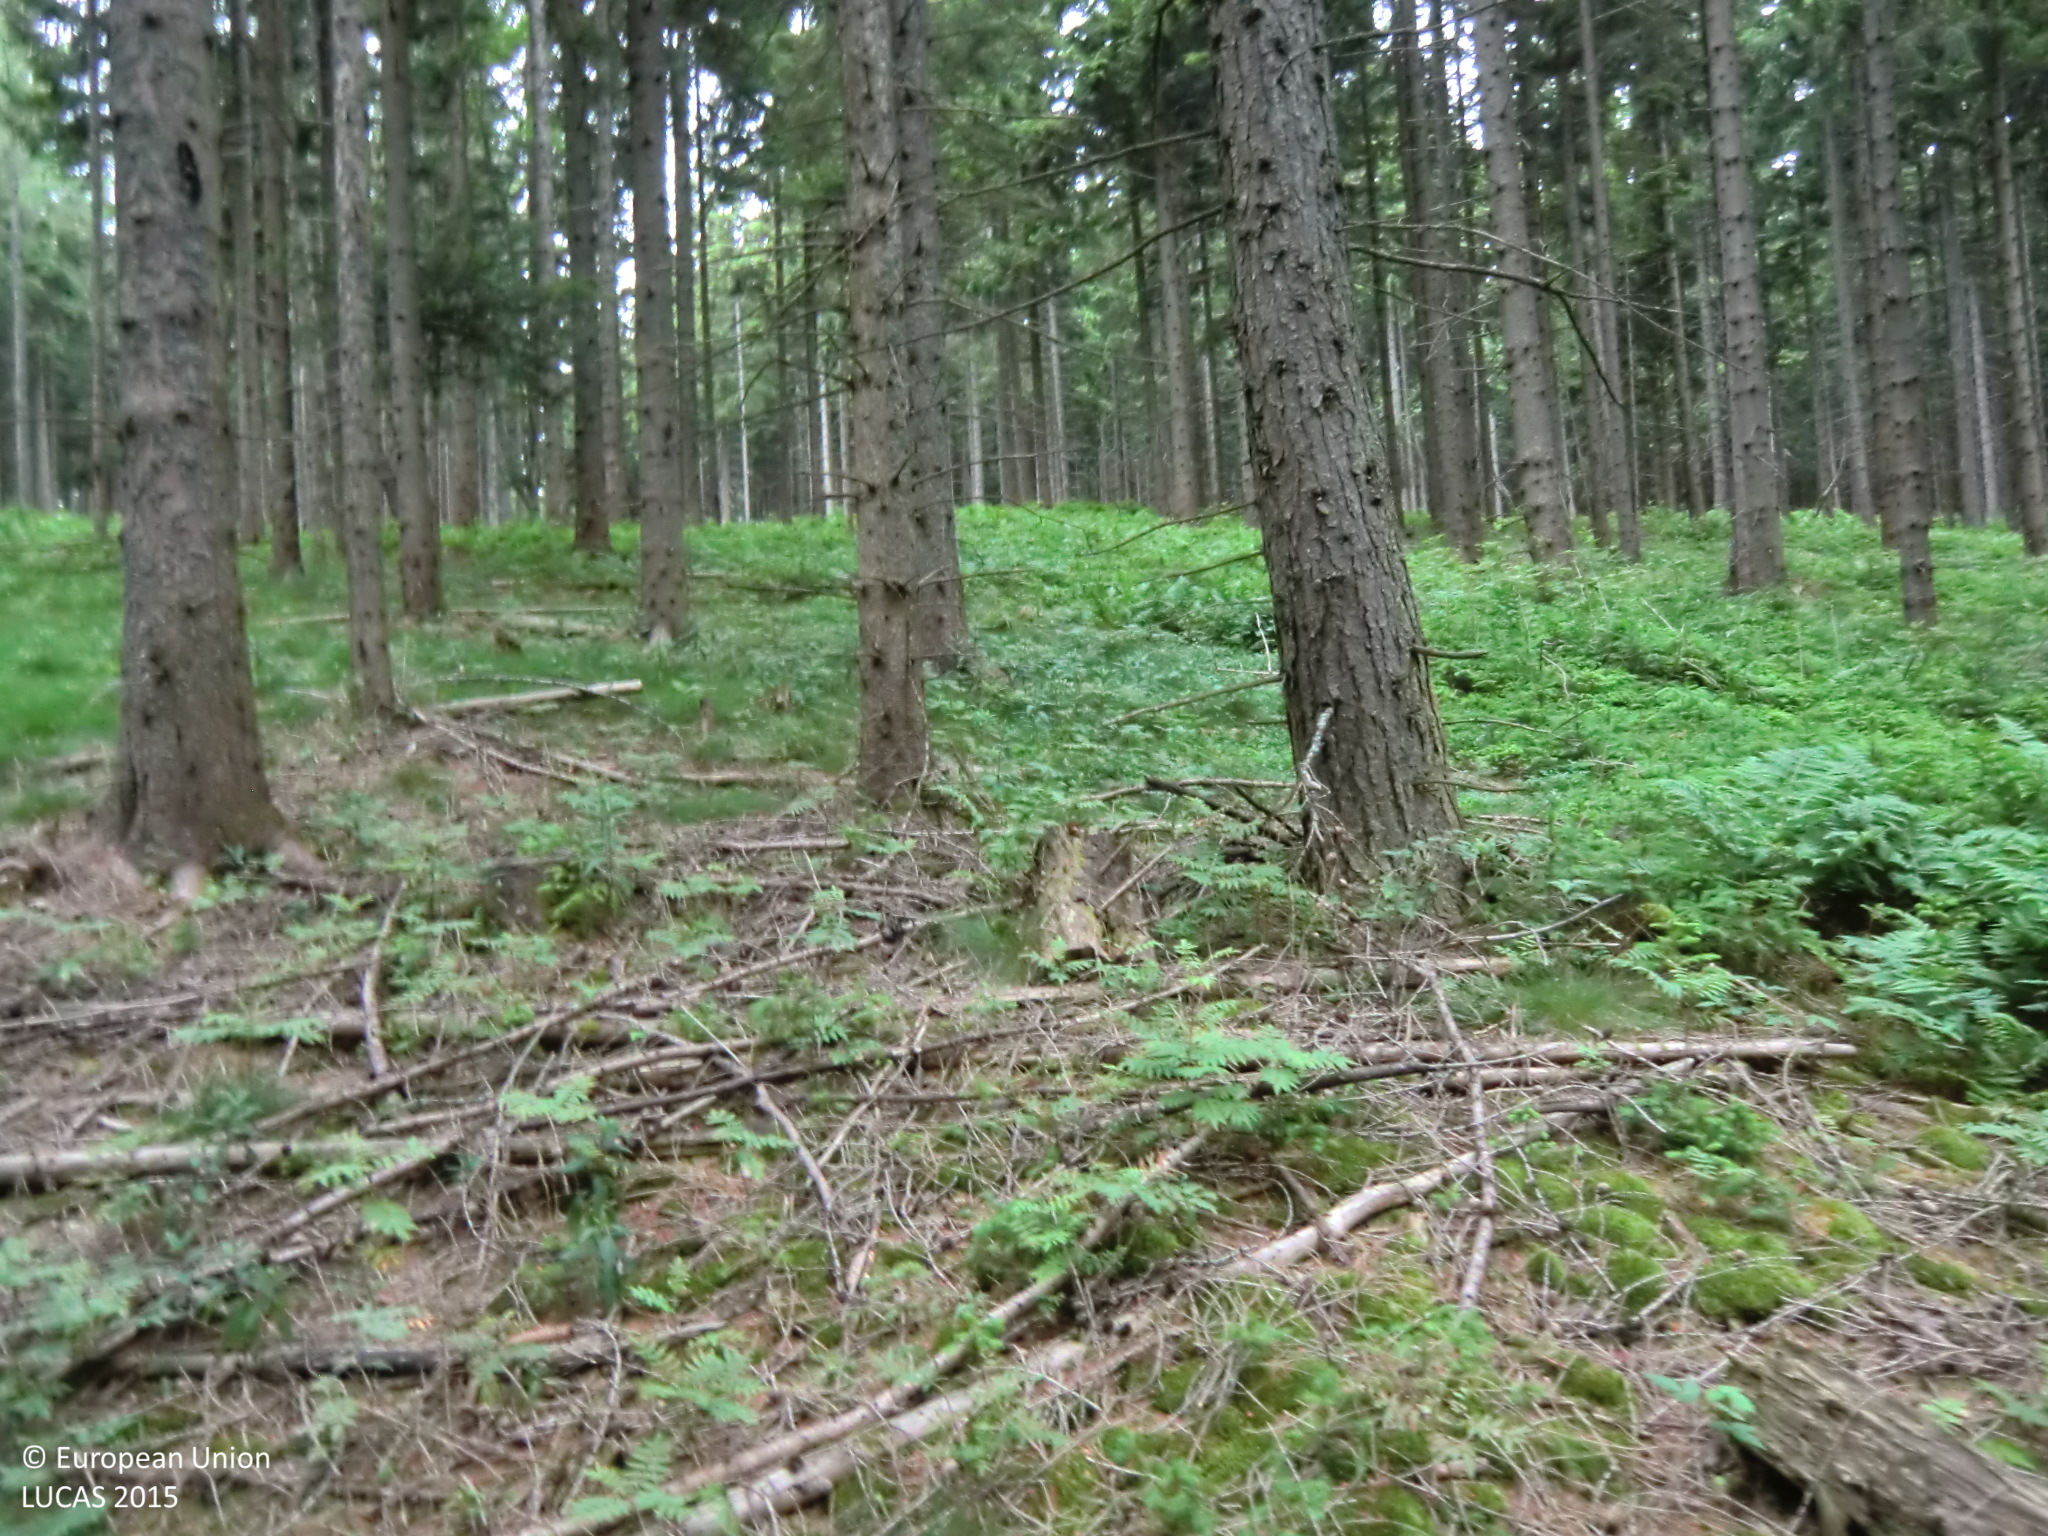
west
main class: Woodland
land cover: Spruce dominated coniferous woodland
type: alpine coniferous forest
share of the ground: > 75 %
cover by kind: coniferous forest trees 80 %, shrubs 10 %, herbaceous plants 10 %
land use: Forestry
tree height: > 5 m
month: June
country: AT
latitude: 47.2974
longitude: 15.7538
